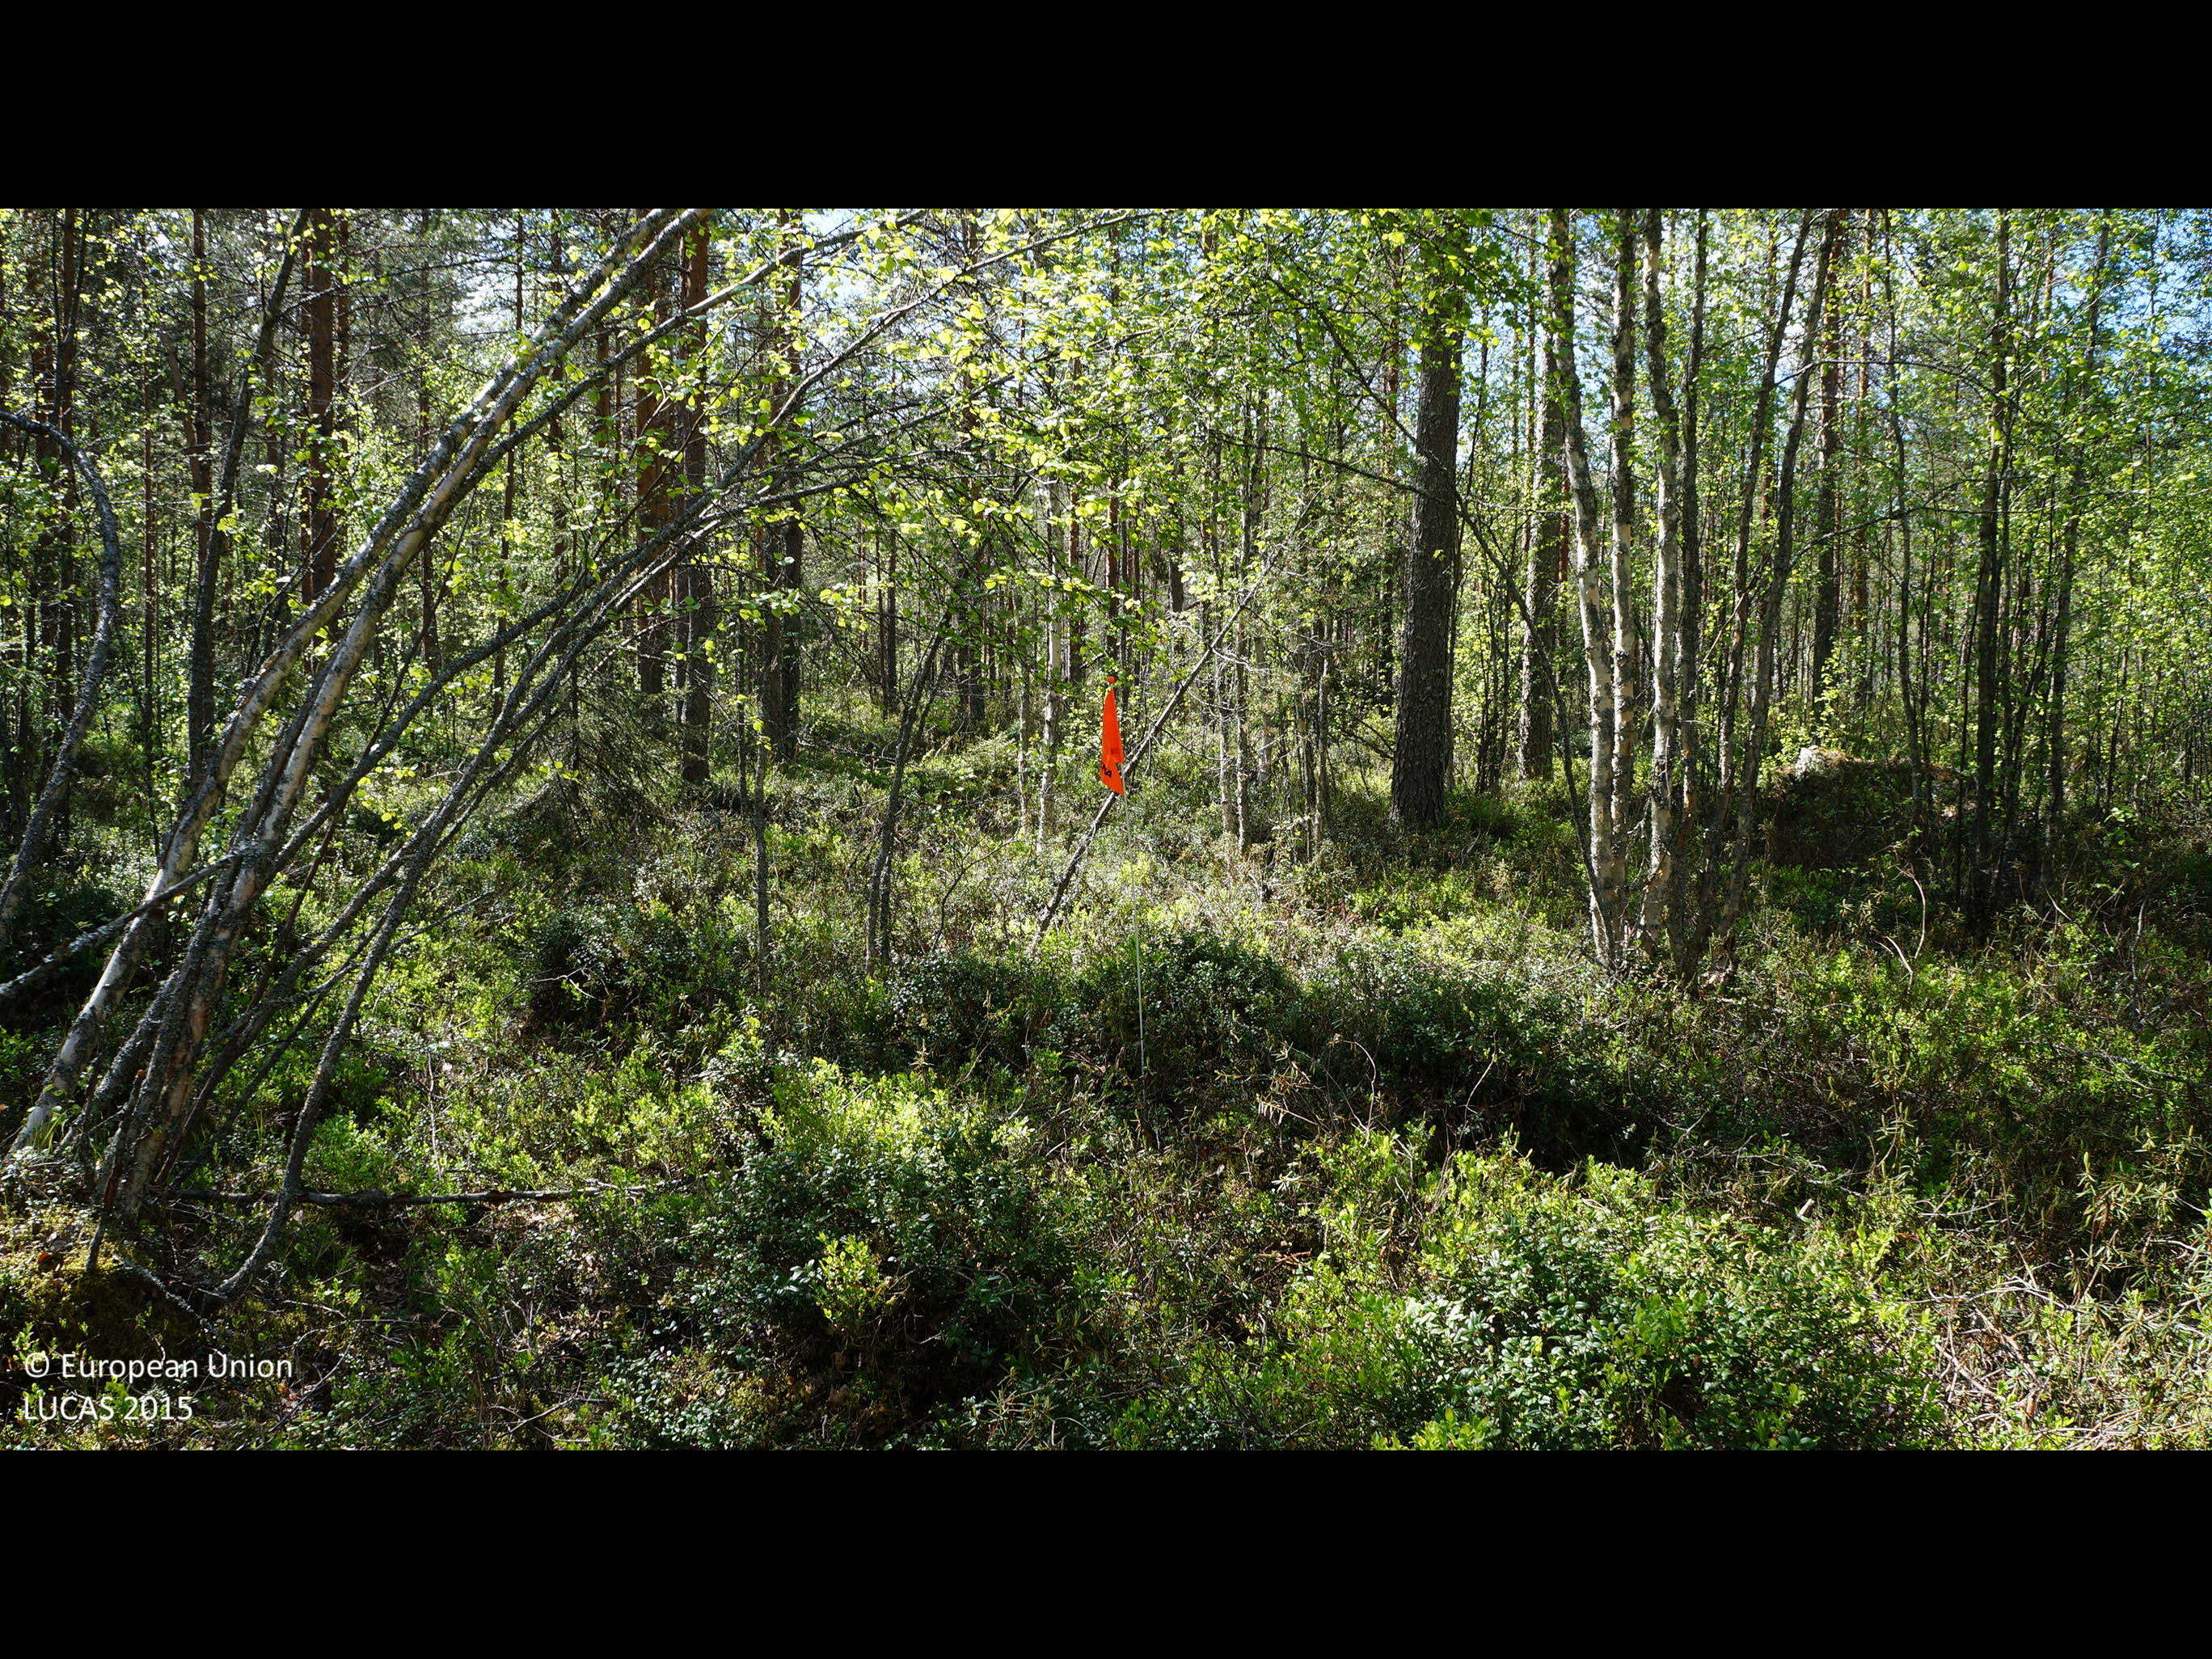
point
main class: Woodland
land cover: Pine dominated mixed woodland
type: boreal forest
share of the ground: > 75 %
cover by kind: coniferous forest trees 65 %, broadleaved forest trees 25 %, shrubs 10 %
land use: Forestry
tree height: > 5 m
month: June
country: FI
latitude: 63.7800
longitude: 23.3032
